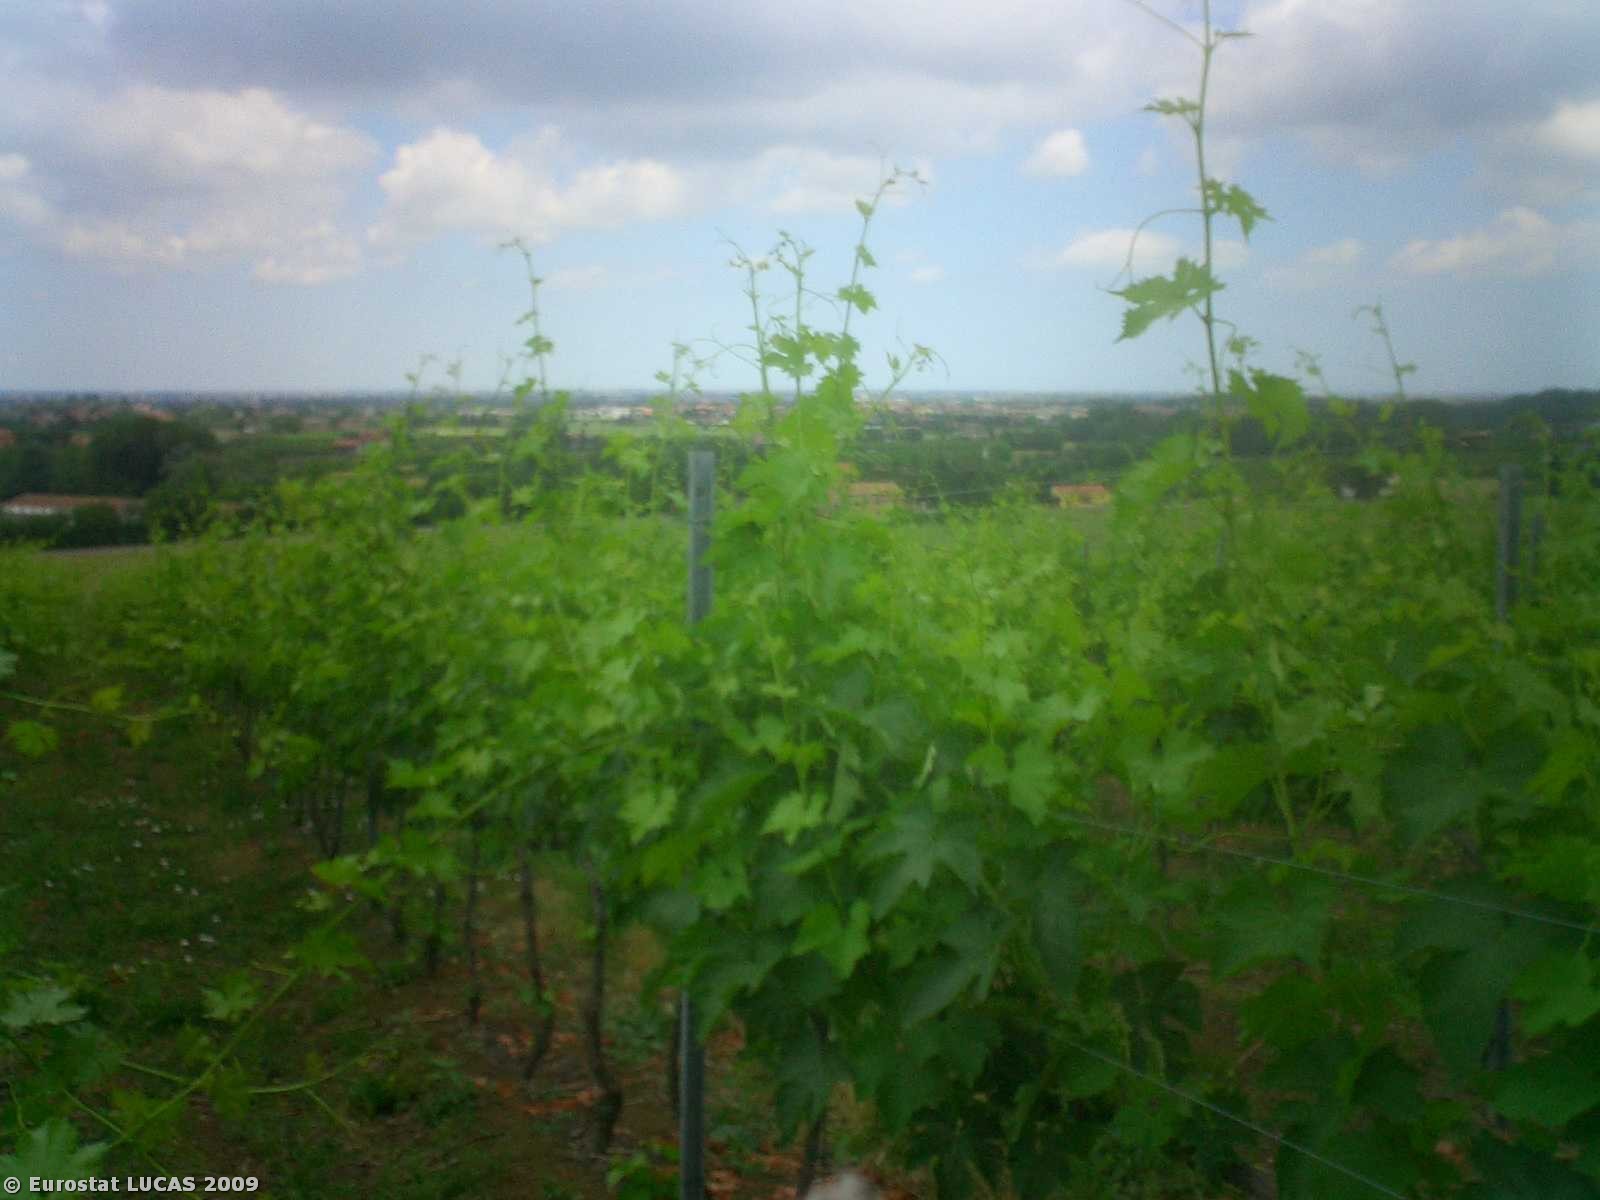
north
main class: Cropland
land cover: Vineyards
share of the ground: 50 - 75 %
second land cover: Grassland without tree/shrub cover
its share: 10 - 25 %
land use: Agriculture (excluding fallow land and kitchen gardens)
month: May
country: IT
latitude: 44.0707
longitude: 12.3793
